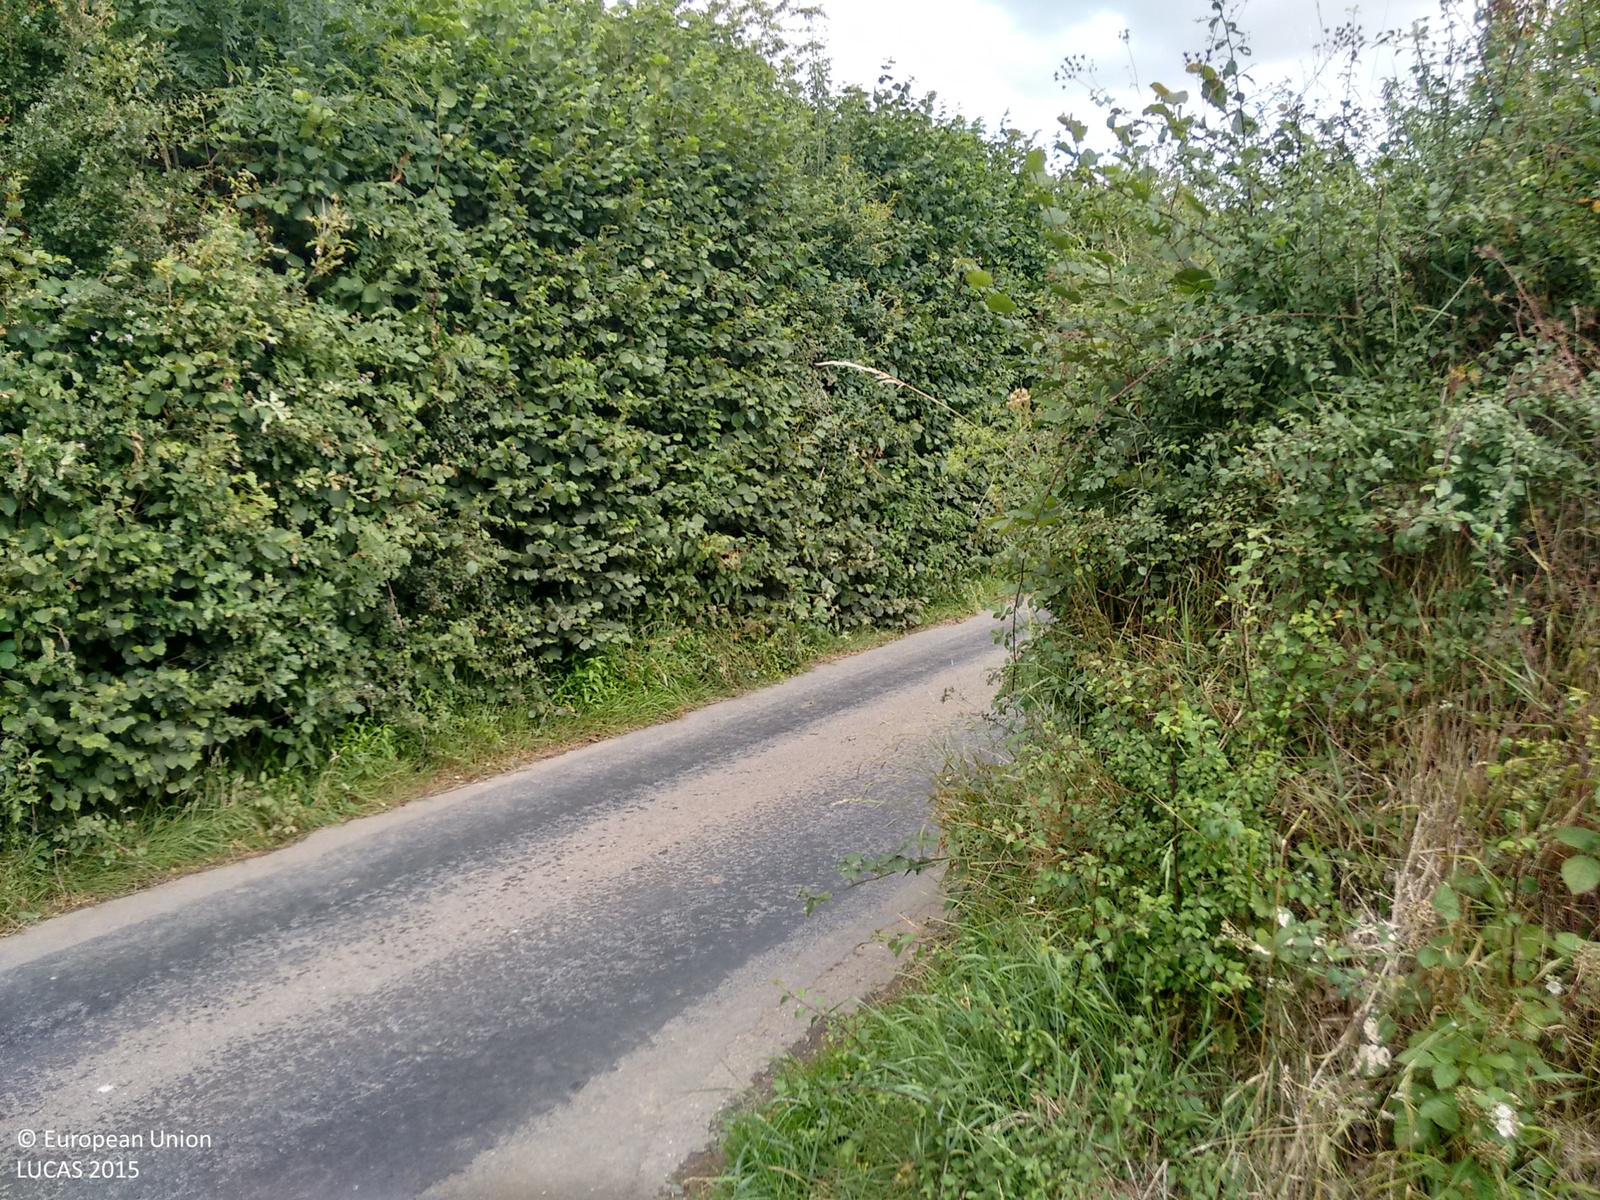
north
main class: Grassland
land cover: Grassland without tree/shrub cover
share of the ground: > 75 %
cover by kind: herbaceous plants 100 %
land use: Agriculture (excluding fallow land and kitchen gardens)
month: August
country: GB
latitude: 50.7701
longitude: -3.7437
